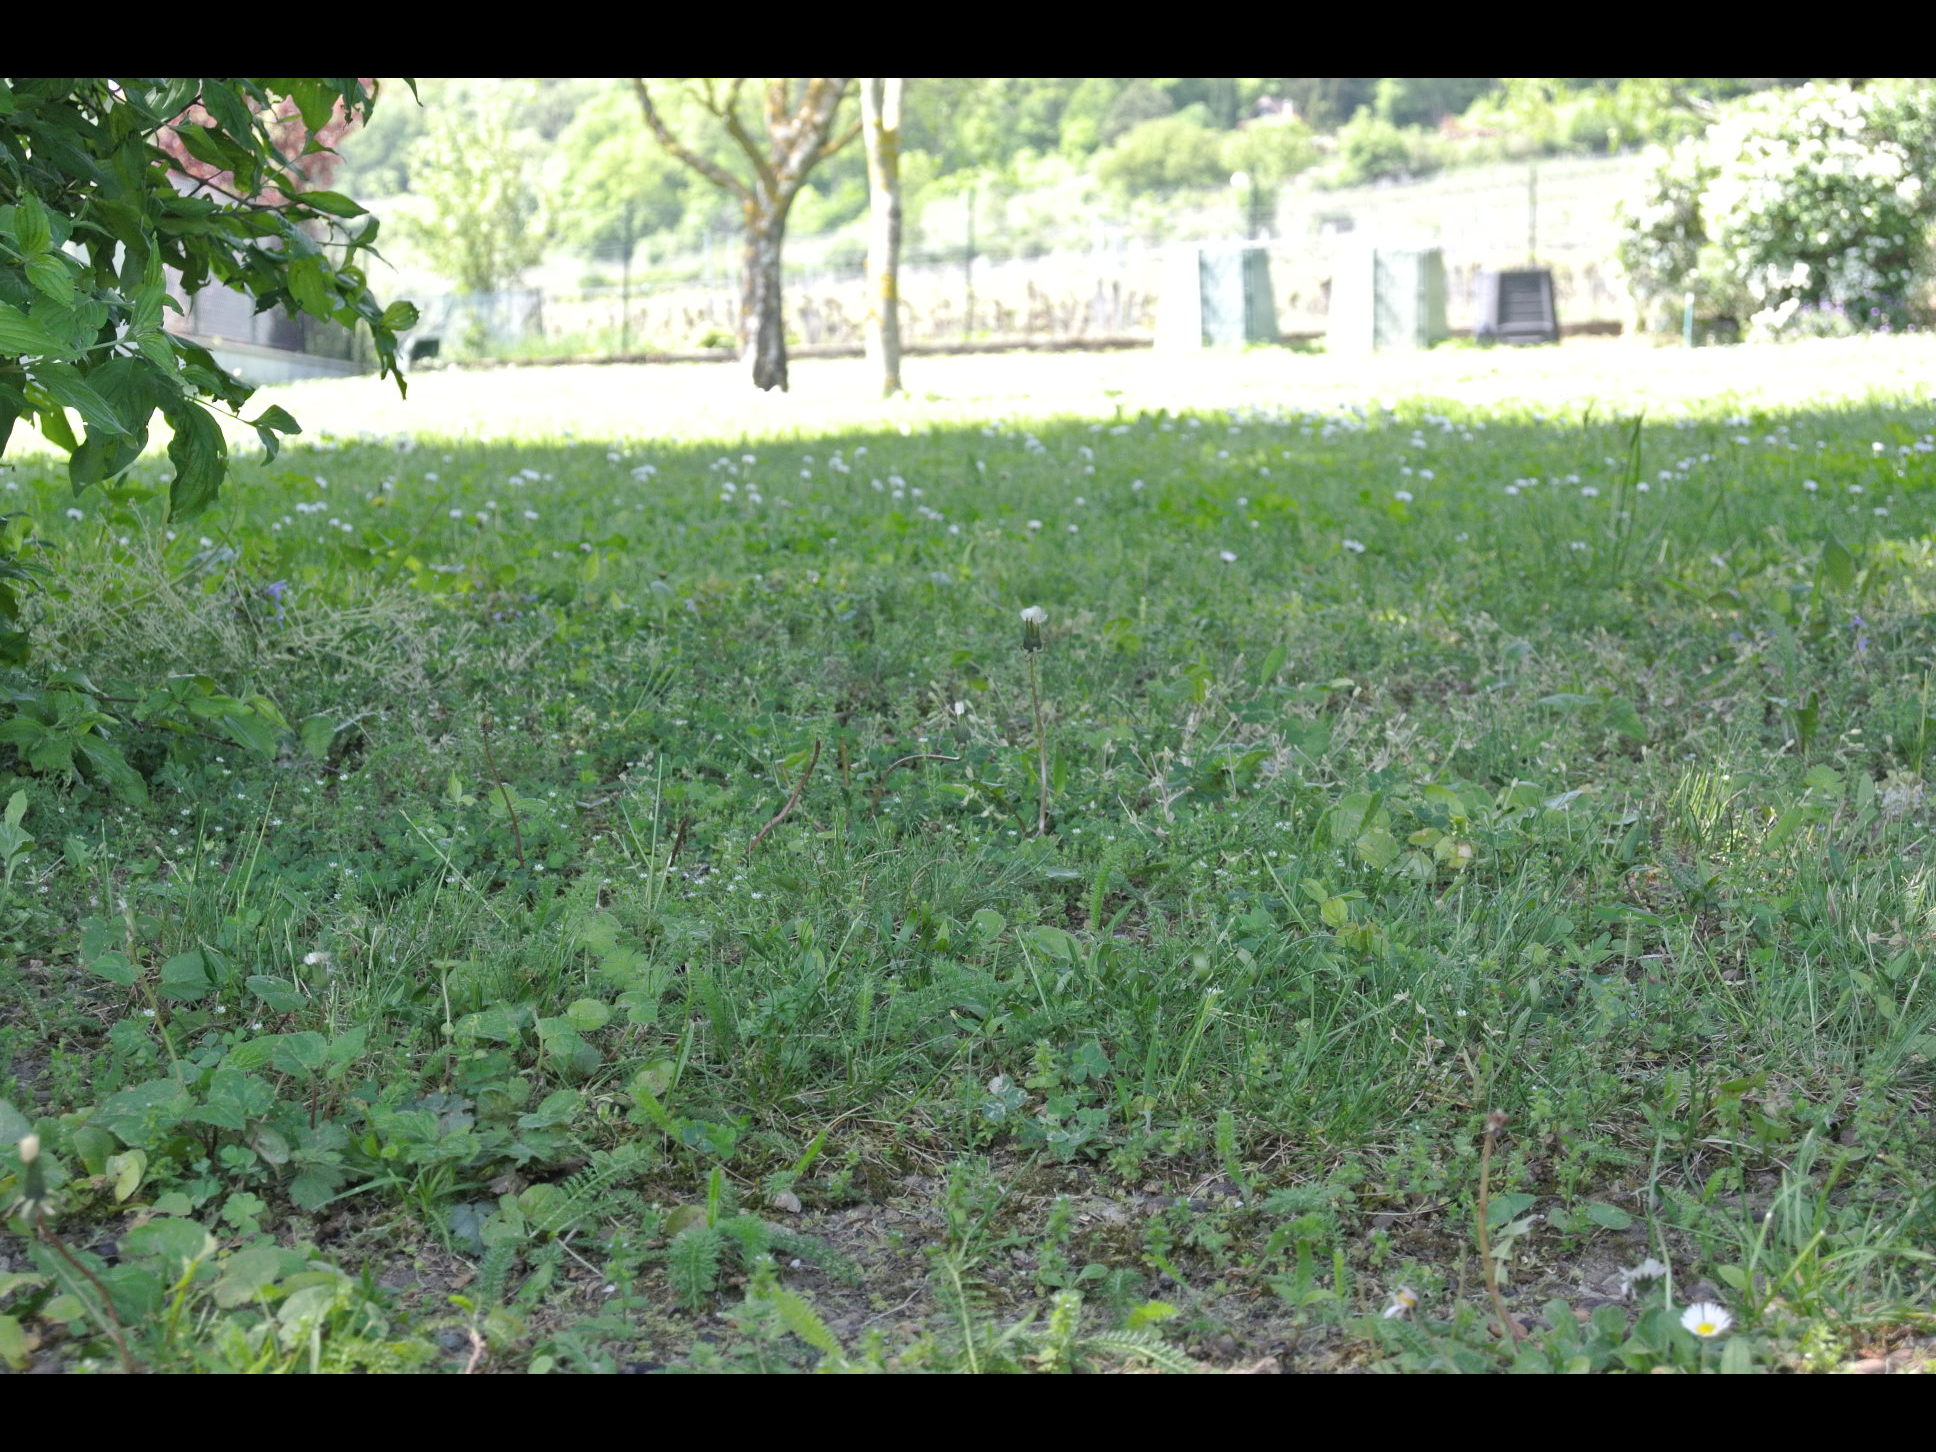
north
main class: Grassland
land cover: Grassland with sparse tree/shrub cover
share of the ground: > 75 %
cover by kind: herbaceous plants 85 %, shrubs 10 %, broadleaved forest trees 5 %
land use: Residential
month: May
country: AT
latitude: 48.1183
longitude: 16.2508
